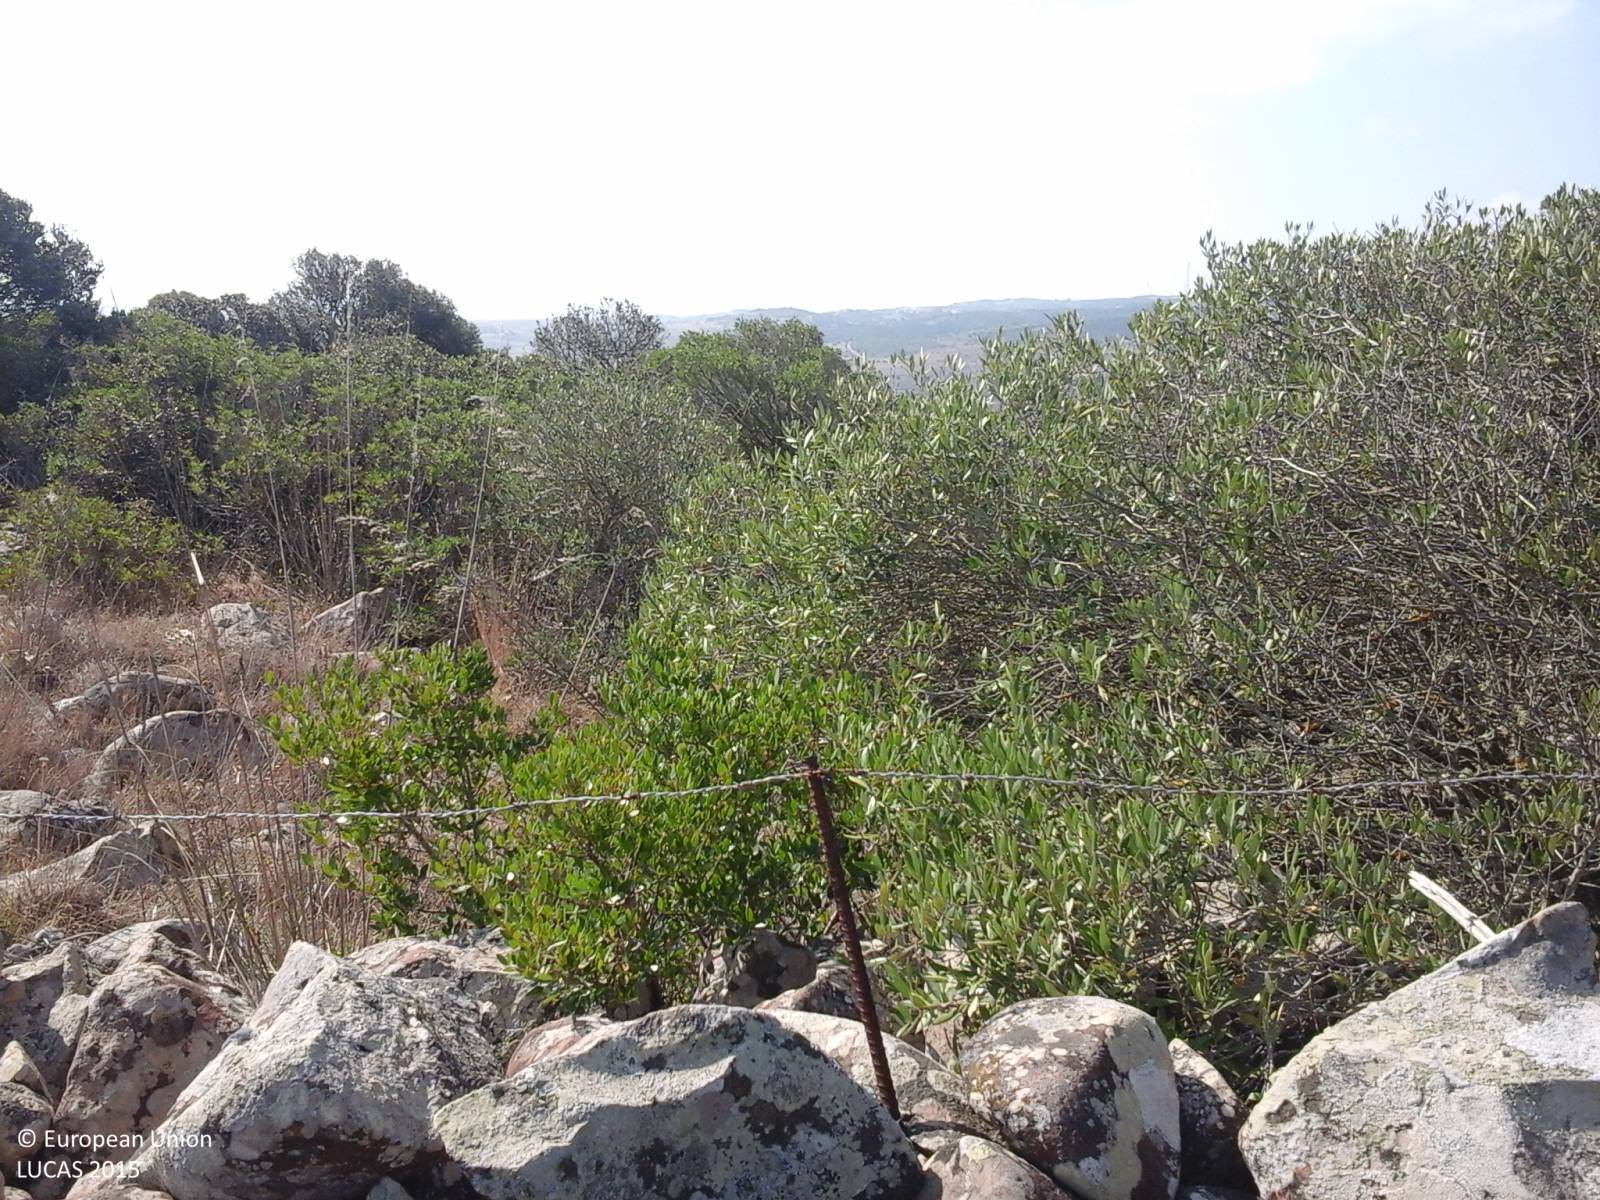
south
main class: Shrubland
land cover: Shrubland without tree cover
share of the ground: > 75 %
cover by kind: shrubs 100 %
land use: Agriculture (excluding fallow land and kitchen gardens)
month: July
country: IT
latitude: 39.6630
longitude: 8.8527
